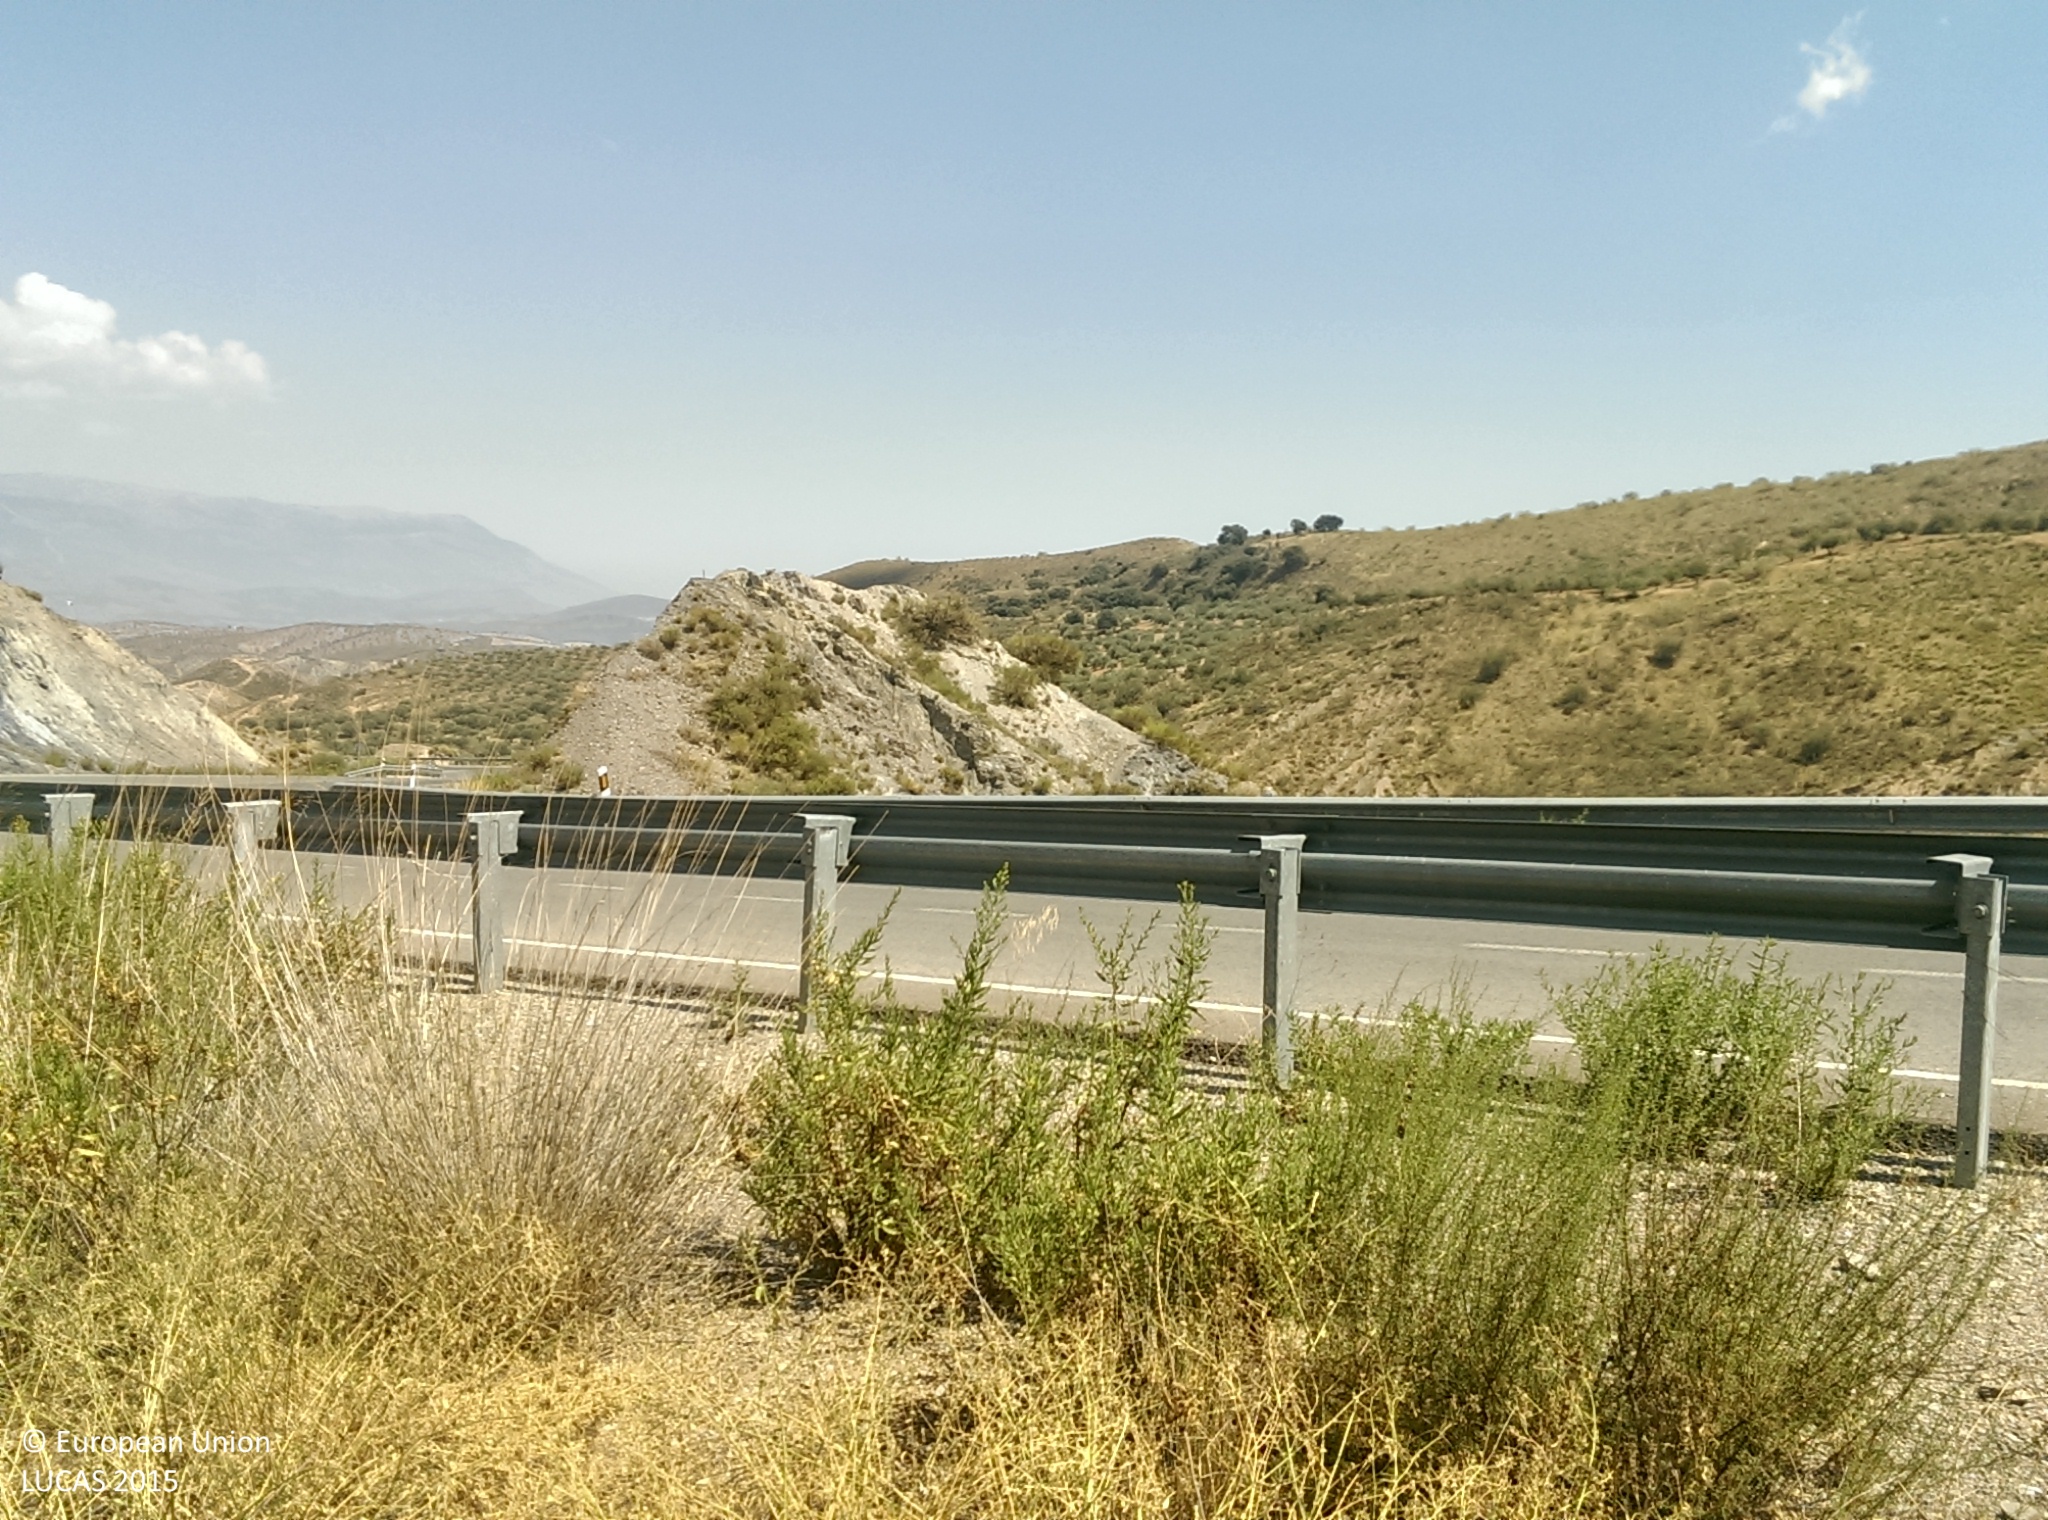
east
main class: Shrubland
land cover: Shrubland without tree cover
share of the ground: 50 - 75 %
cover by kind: shrubs 60 %, herbaceous plants 30 %, unconsolidated bare surface 10 %
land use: Semi-natural and natural areas not in use
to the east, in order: Shrubland without tree cover
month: July
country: ES
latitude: 36.9577
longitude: -3.1556
